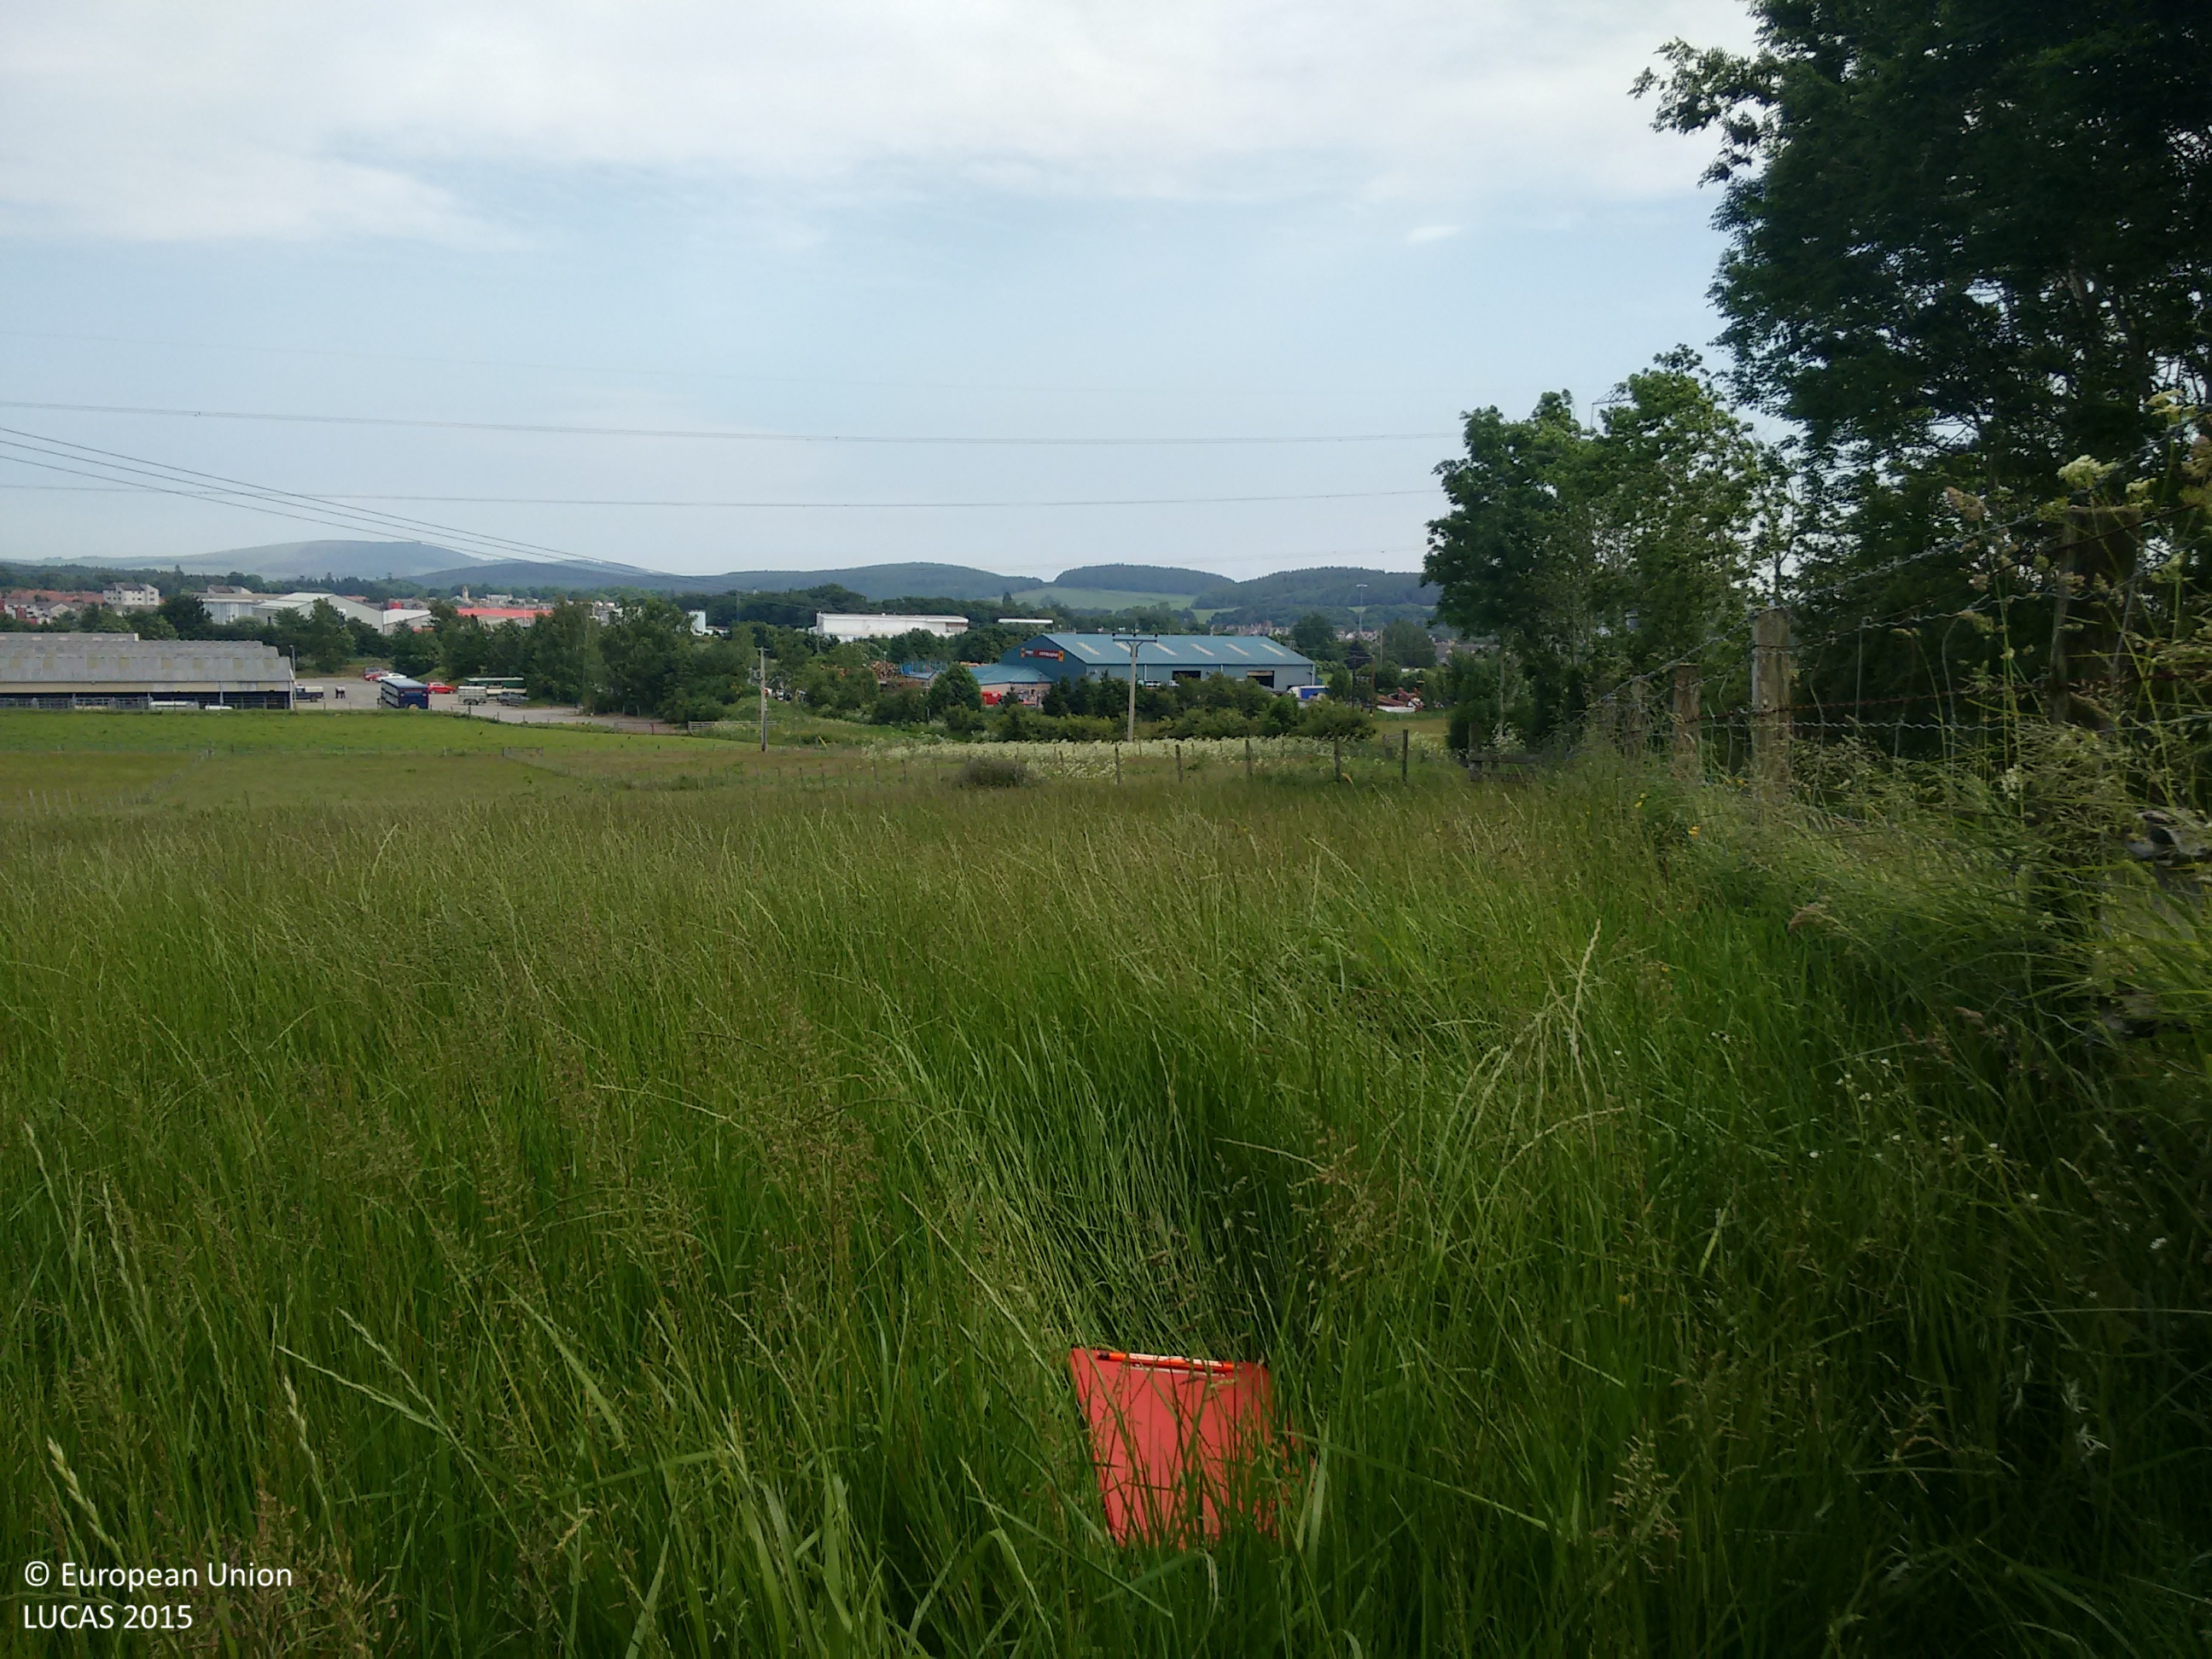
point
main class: Grassland
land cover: Grassland without tree/shrub cover
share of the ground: > 75 %
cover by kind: herbaceous plants 100 %
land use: Agriculture (excluding fallow land and kitchen gardens)
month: July
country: GB
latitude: 57.4397
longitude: -2.8028
